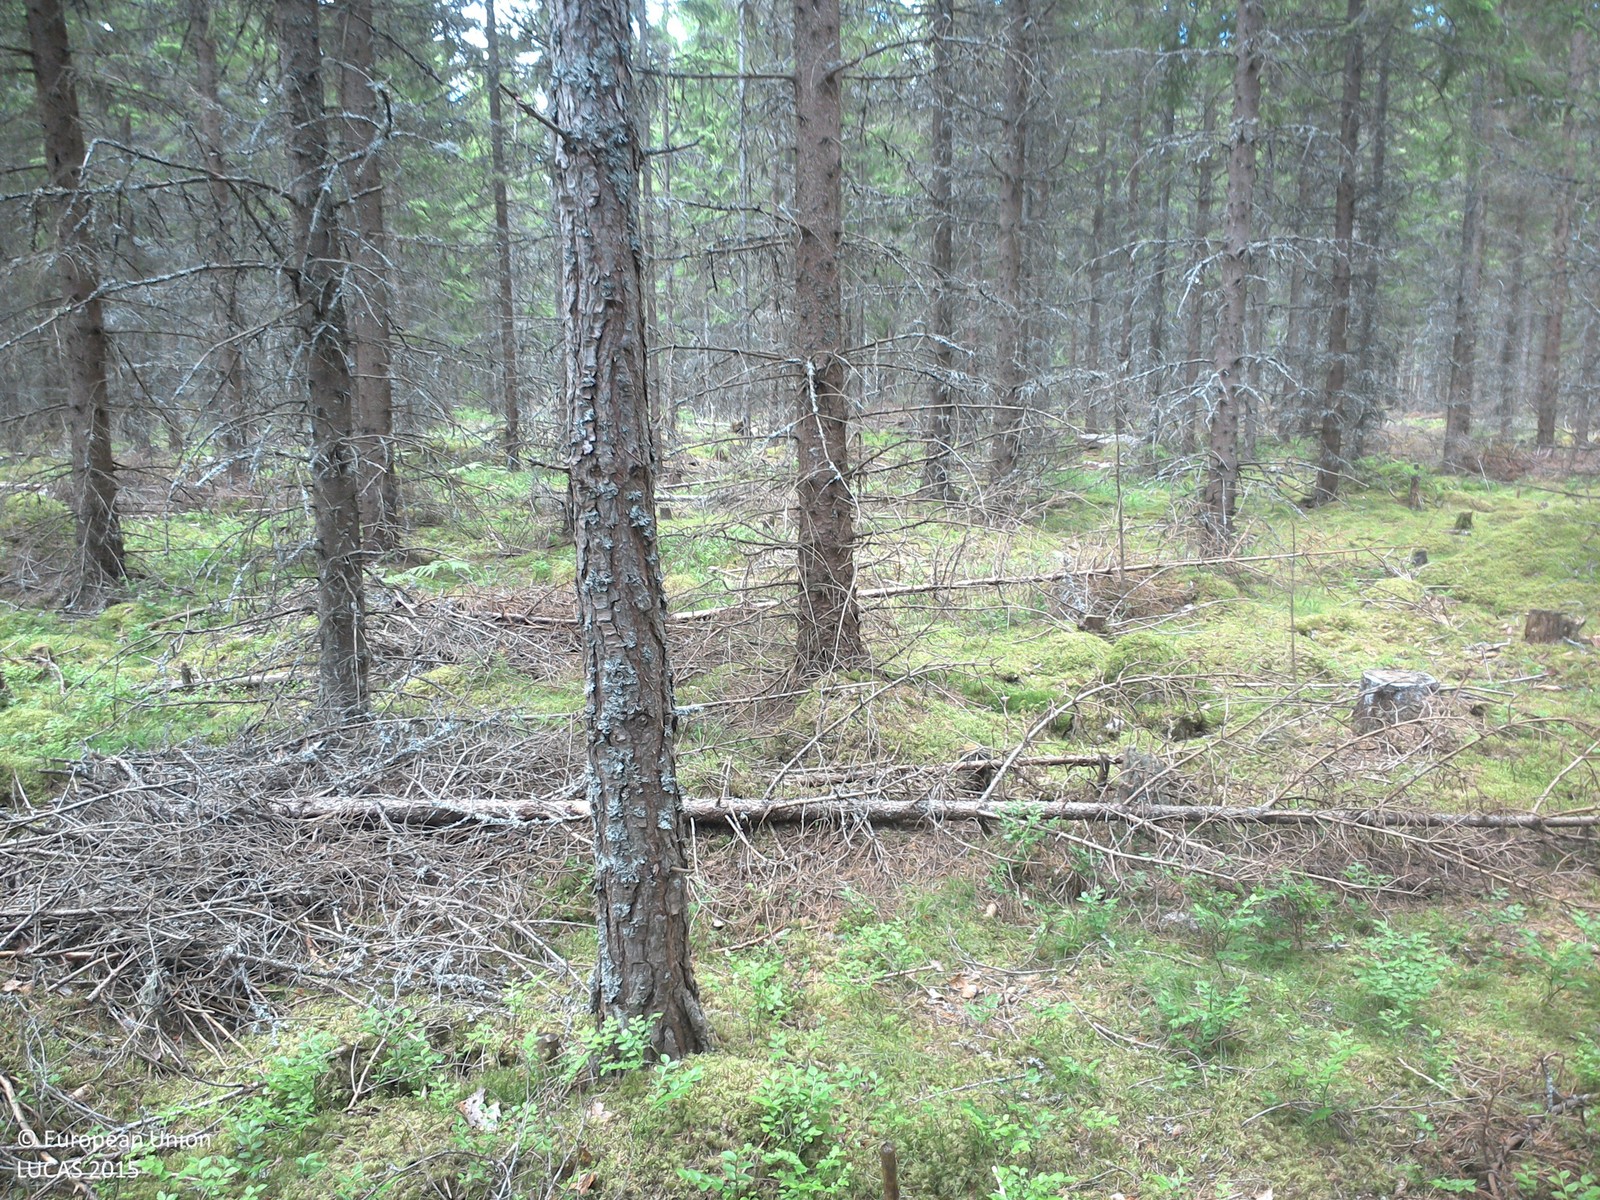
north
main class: Woodland
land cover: Spruce dominated coniferous woodland
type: boreal forest
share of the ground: 50 - 75 %
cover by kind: coniferous forest trees 60 %, lichens and mosses 35 %, shrubs 5 %
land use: Forestry
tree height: > 5 m
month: June
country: SE
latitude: 57.9610
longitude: 15.9625
